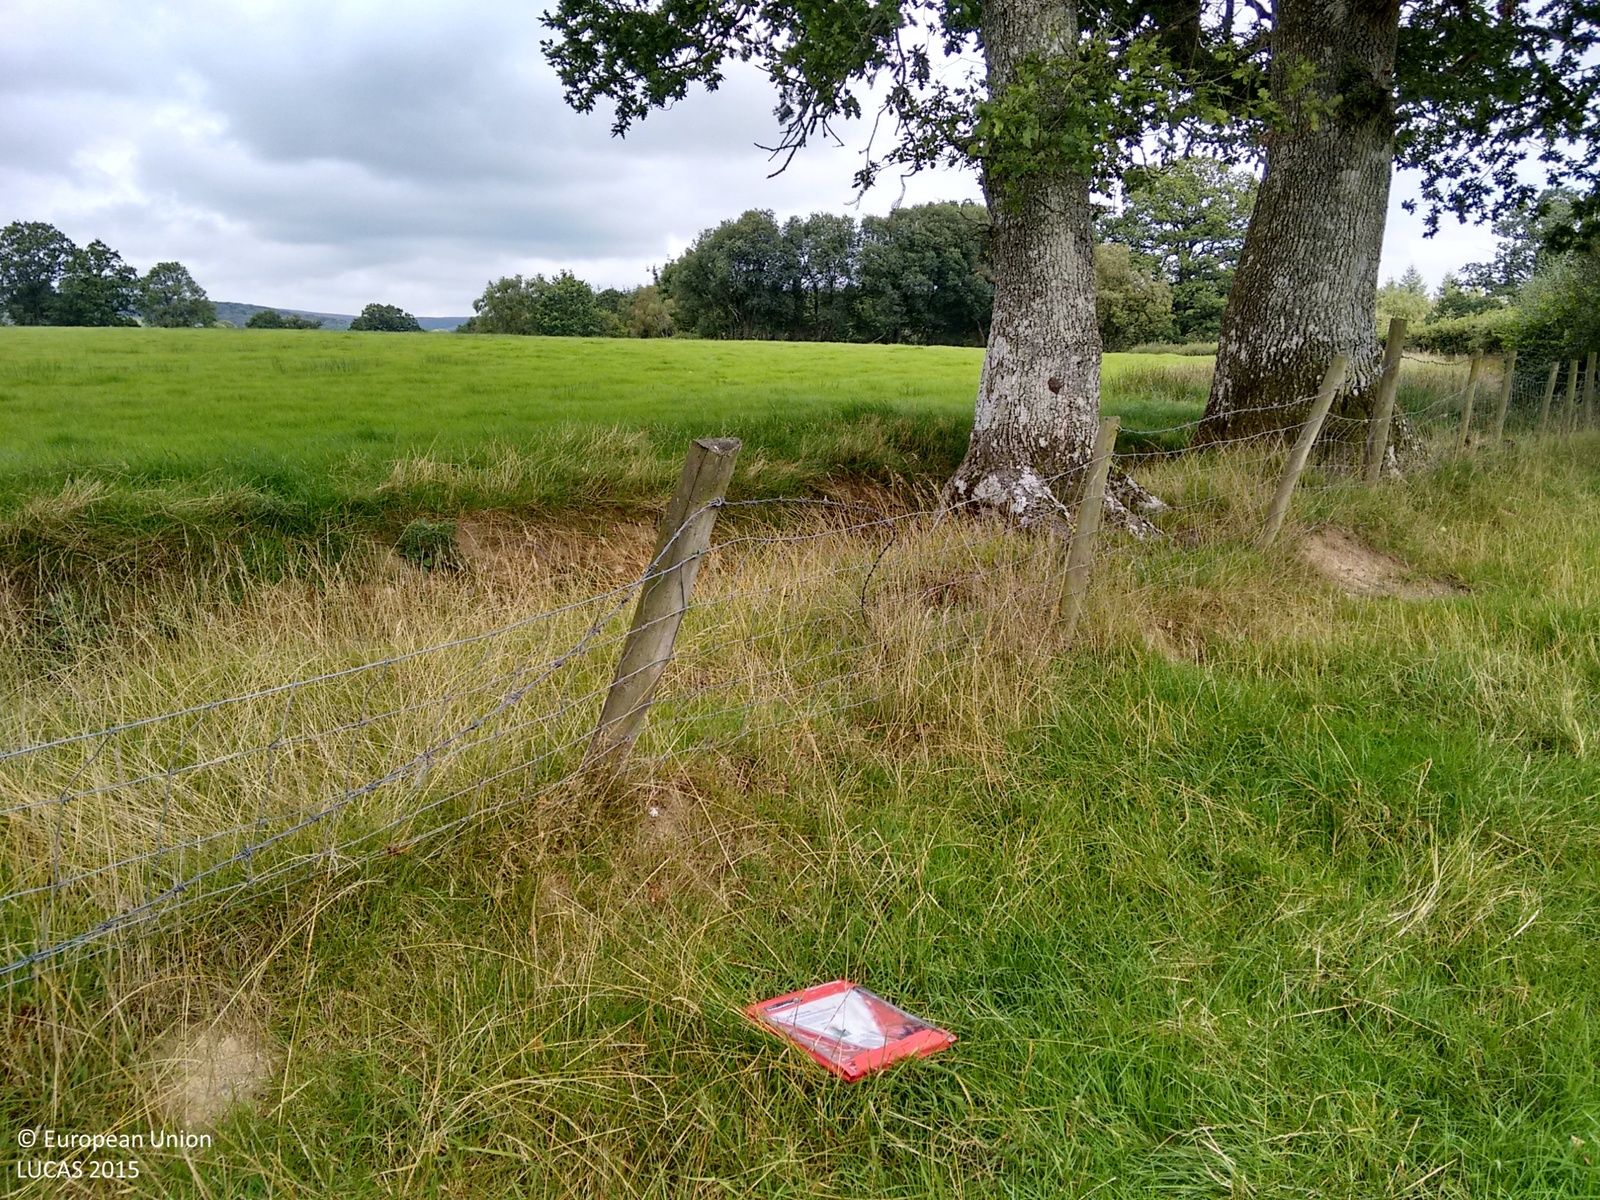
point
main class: Grassland
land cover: Grassland without tree/shrub cover
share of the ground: > 75 %
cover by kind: herbaceous plants 100 %
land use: Agriculture (excluding fallow land and kitchen gardens)
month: September
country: GB
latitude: 52.1890
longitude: -3.4681
